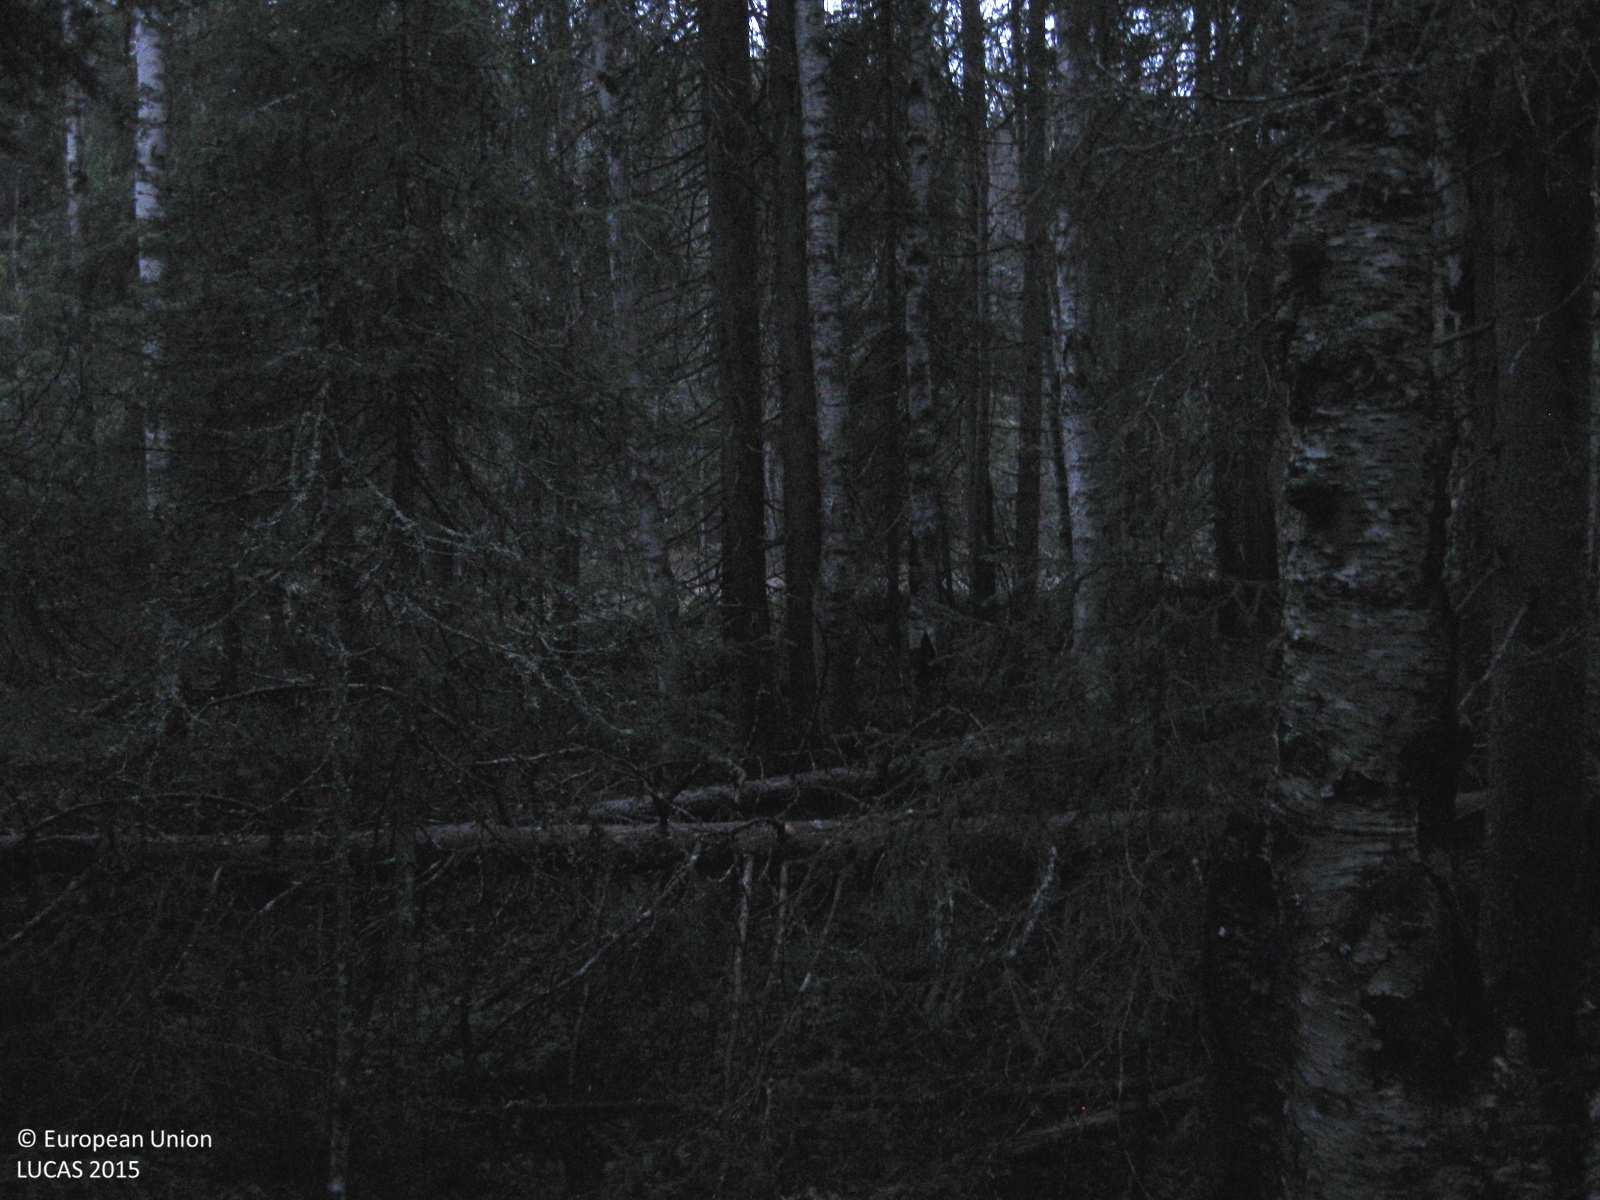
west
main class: Woodland
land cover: Spruce dominated mixed woodland
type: boreal forest
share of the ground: > 75 %
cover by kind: coniferous forest trees 50 %, broadleaved forest trees 25 %, herbaceous plants 10 %, shrubs 5 %, lichens and mosses 5 %
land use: Forestry
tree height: > 5 m
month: October
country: SE
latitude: 66.3281
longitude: 21.4143
